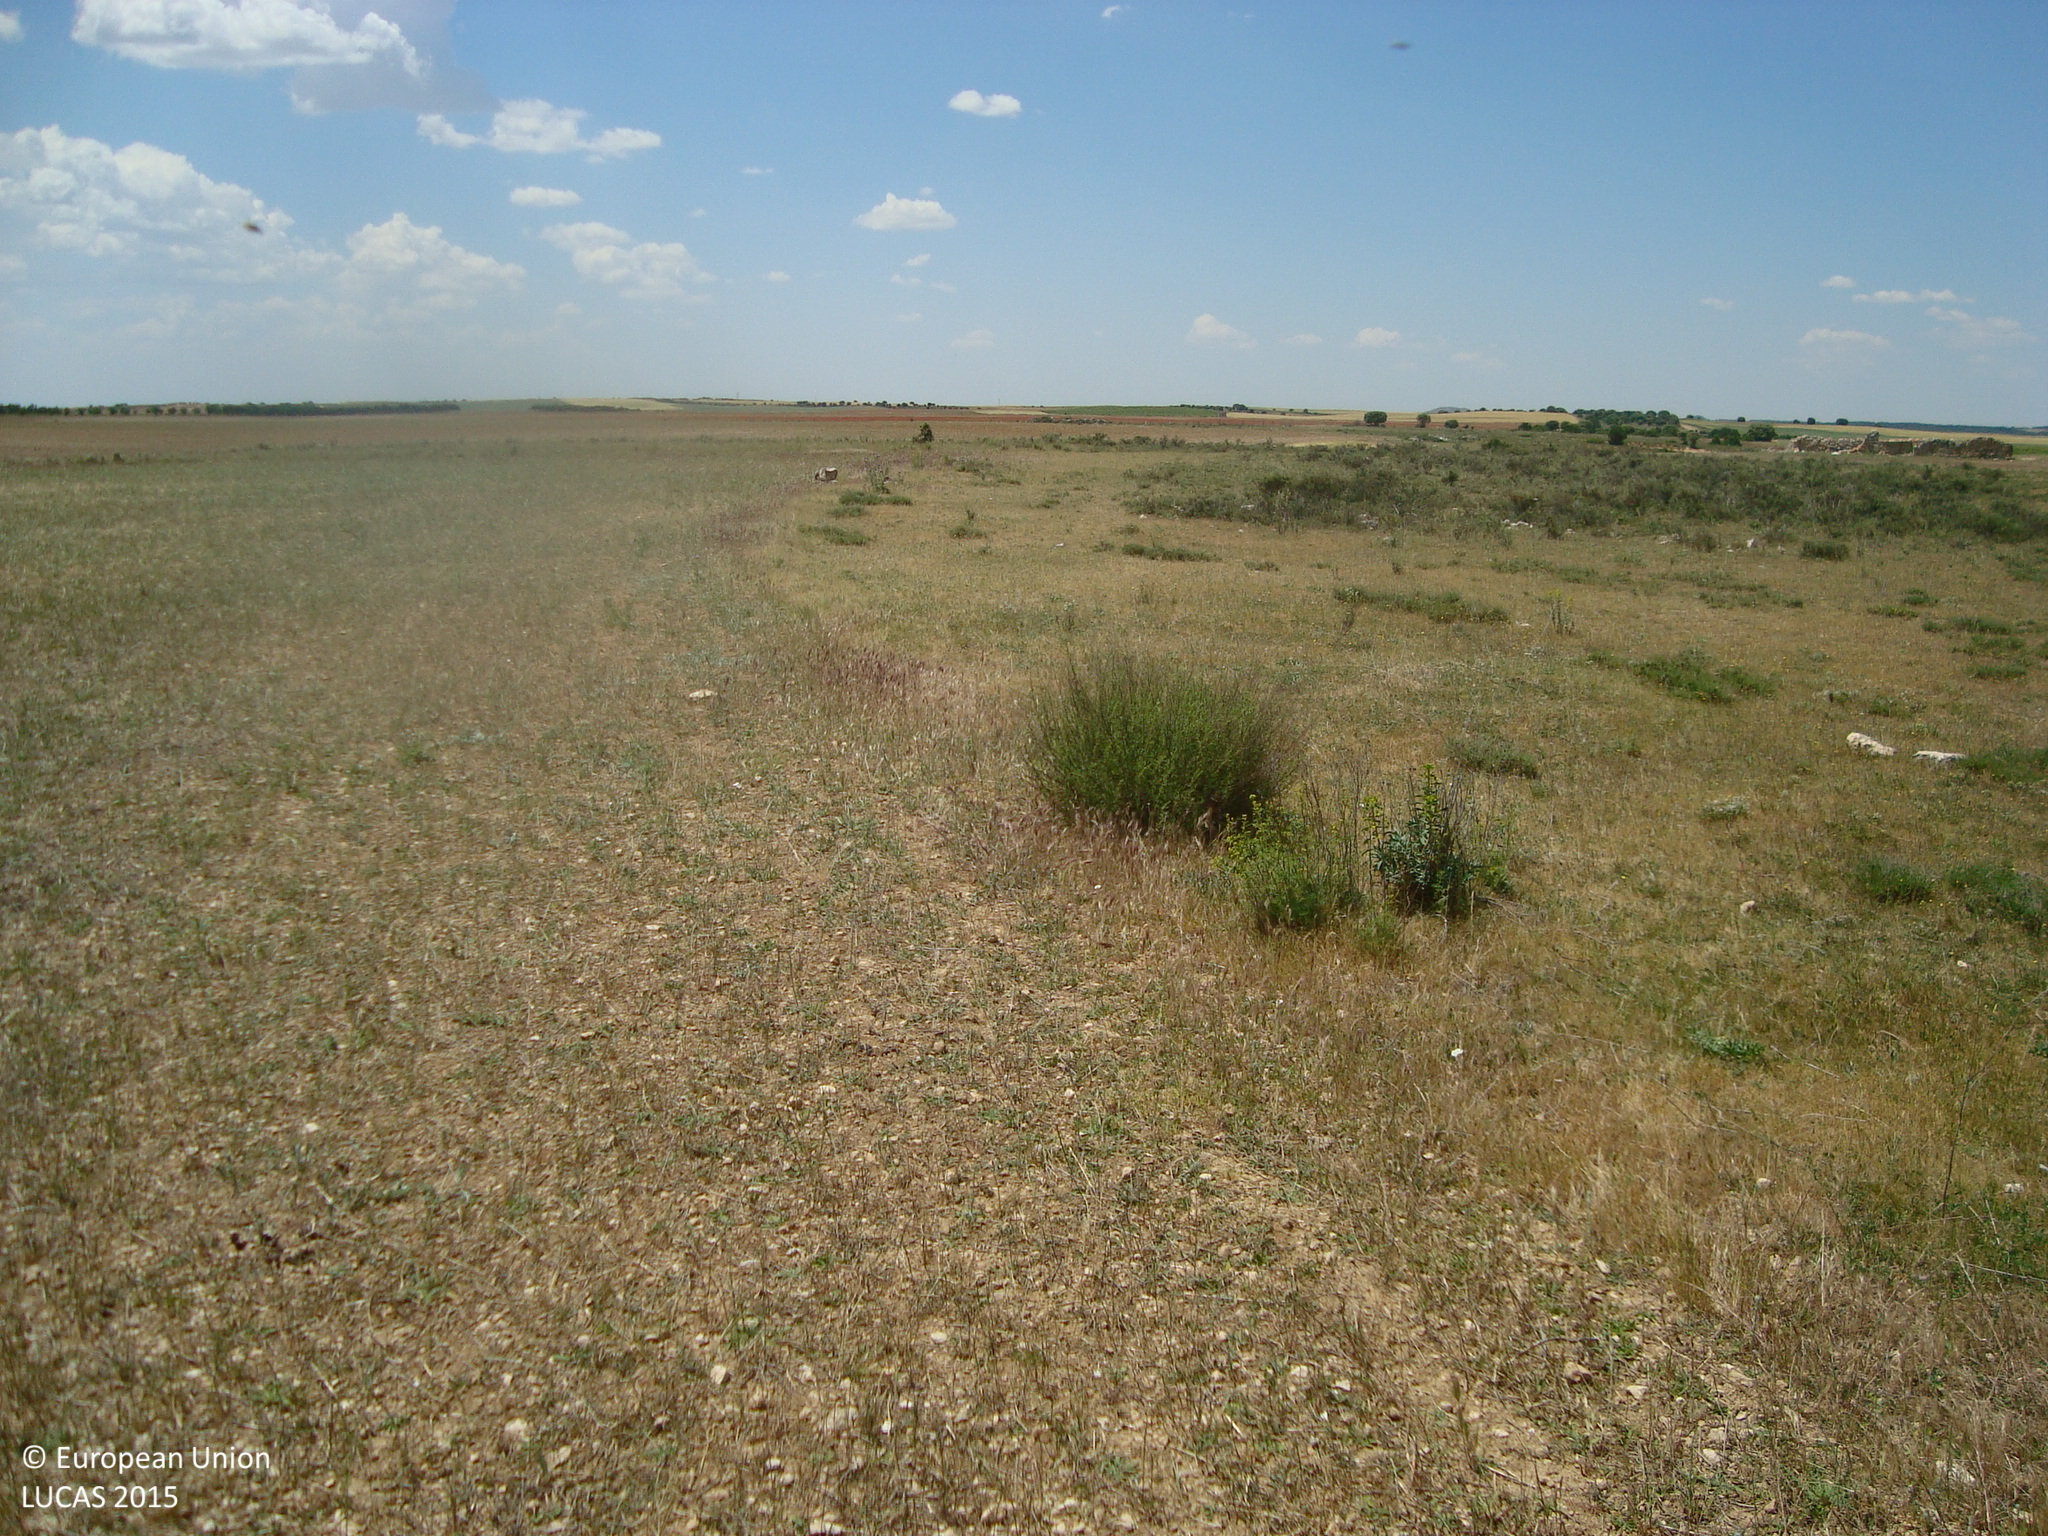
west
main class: Grassland
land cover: Spontaneously vegetated surfaces
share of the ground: 25 - 50 %
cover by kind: unconsolidated bare surface 75 %, herbaceous plants 25 %
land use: Agriculture (excluding fallow land and kitchen gardens)
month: June
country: ES
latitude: 41.7947
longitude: -3.5424
